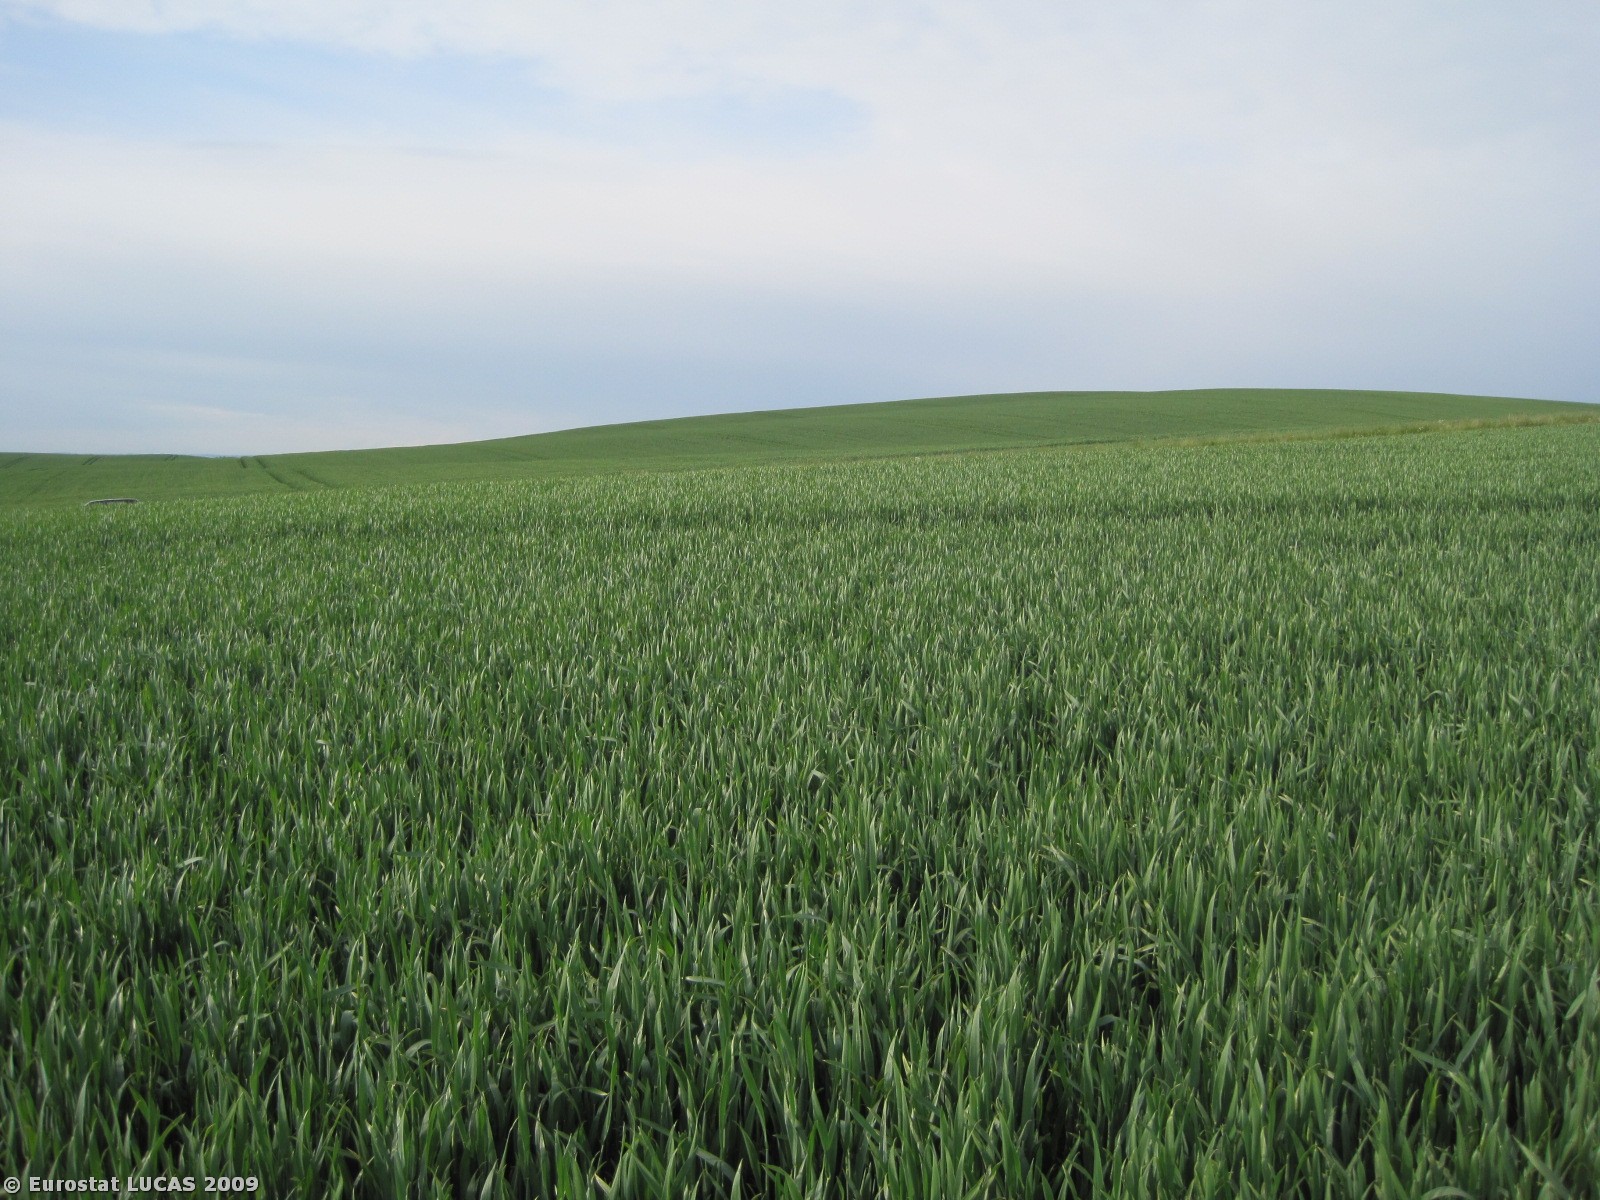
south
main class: Cropland
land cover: Common wheat
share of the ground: > 75 %
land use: Agriculture (excluding fallow land and kitchen gardens)
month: June
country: DK
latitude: 57.5361
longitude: 9.9833
